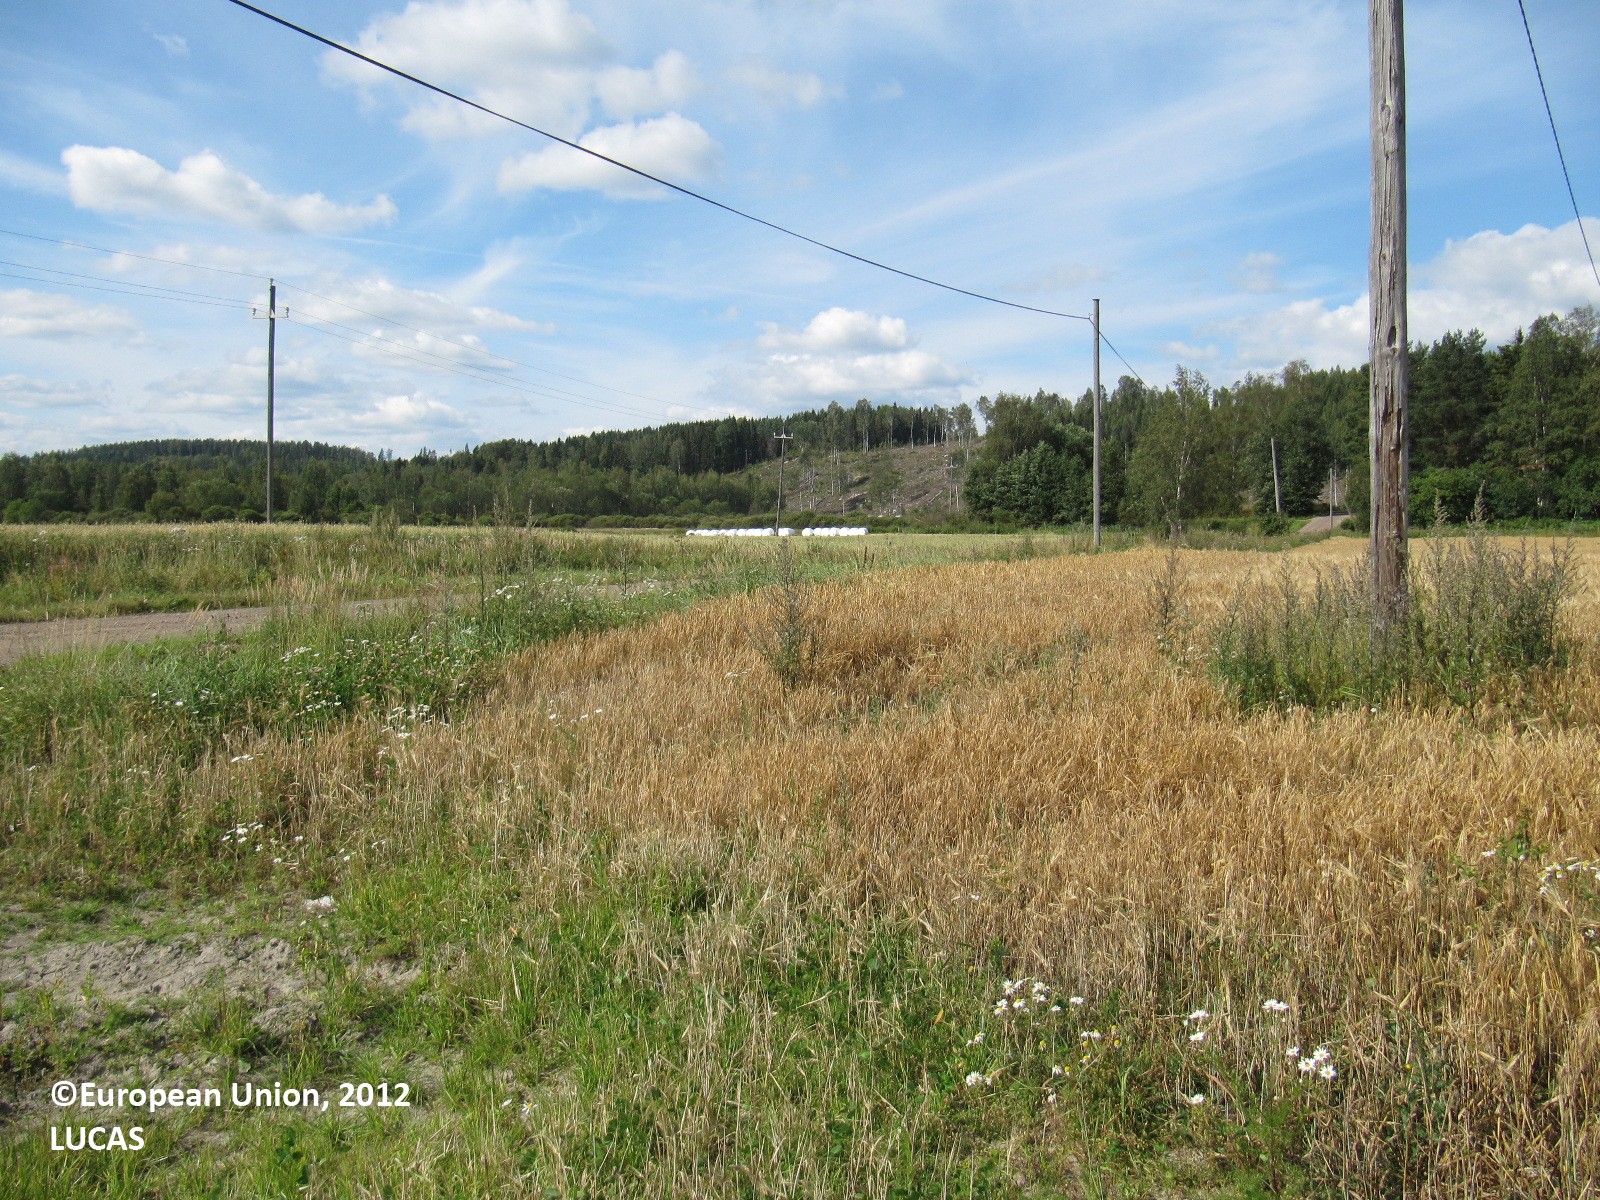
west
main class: Cropland
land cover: Barley
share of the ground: > 75 %
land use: Agriculture (excluding fallow land and kitchen gardens)
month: August
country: FI
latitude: 60.4658
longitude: 24.3803
